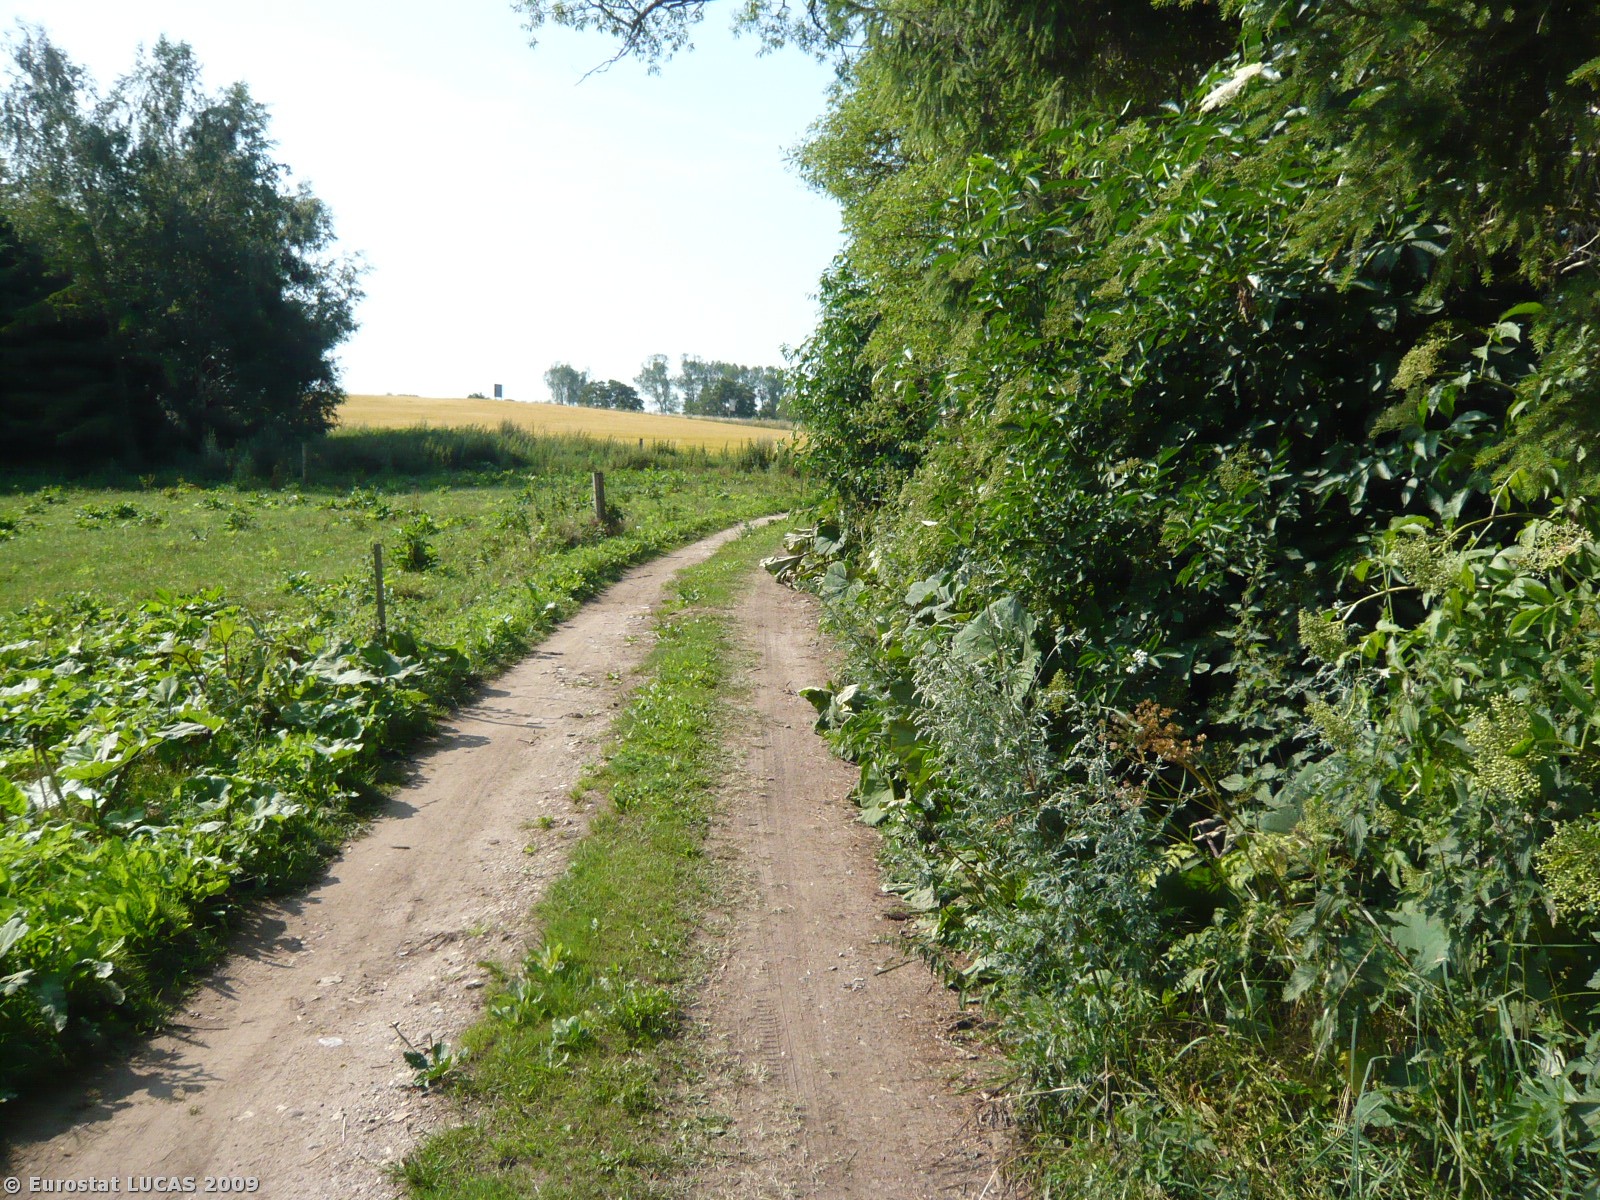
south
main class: Woodland
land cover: Coniferous woodland
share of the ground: > 75 %
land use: Unused
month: July
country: DK
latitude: 55.6358
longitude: 11.7935
